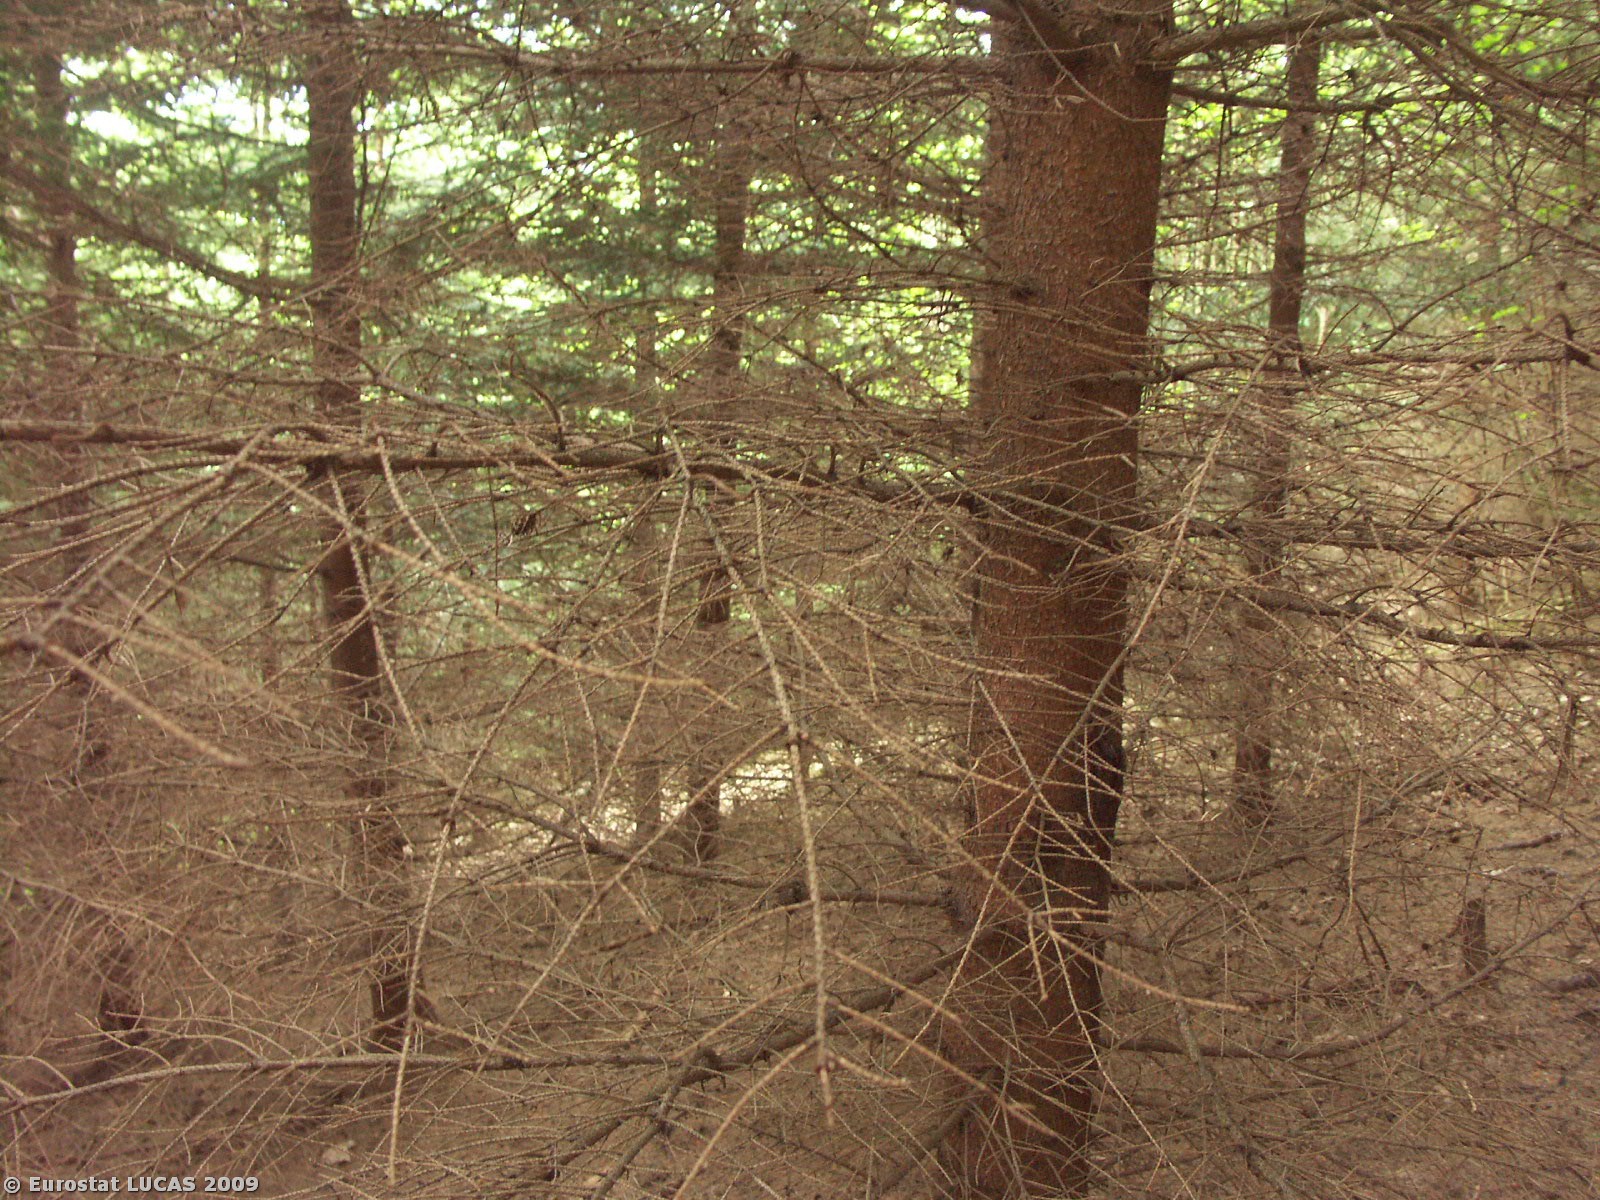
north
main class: Woodland
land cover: Coniferous woodland
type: hemiboreal forest and nemoral coniferous forest and mixed broadleaved-coniferous forest
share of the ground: > 75 %
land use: Forestry
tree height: > 5 m
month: May
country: CZ
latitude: 48.6860
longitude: 14.6059
